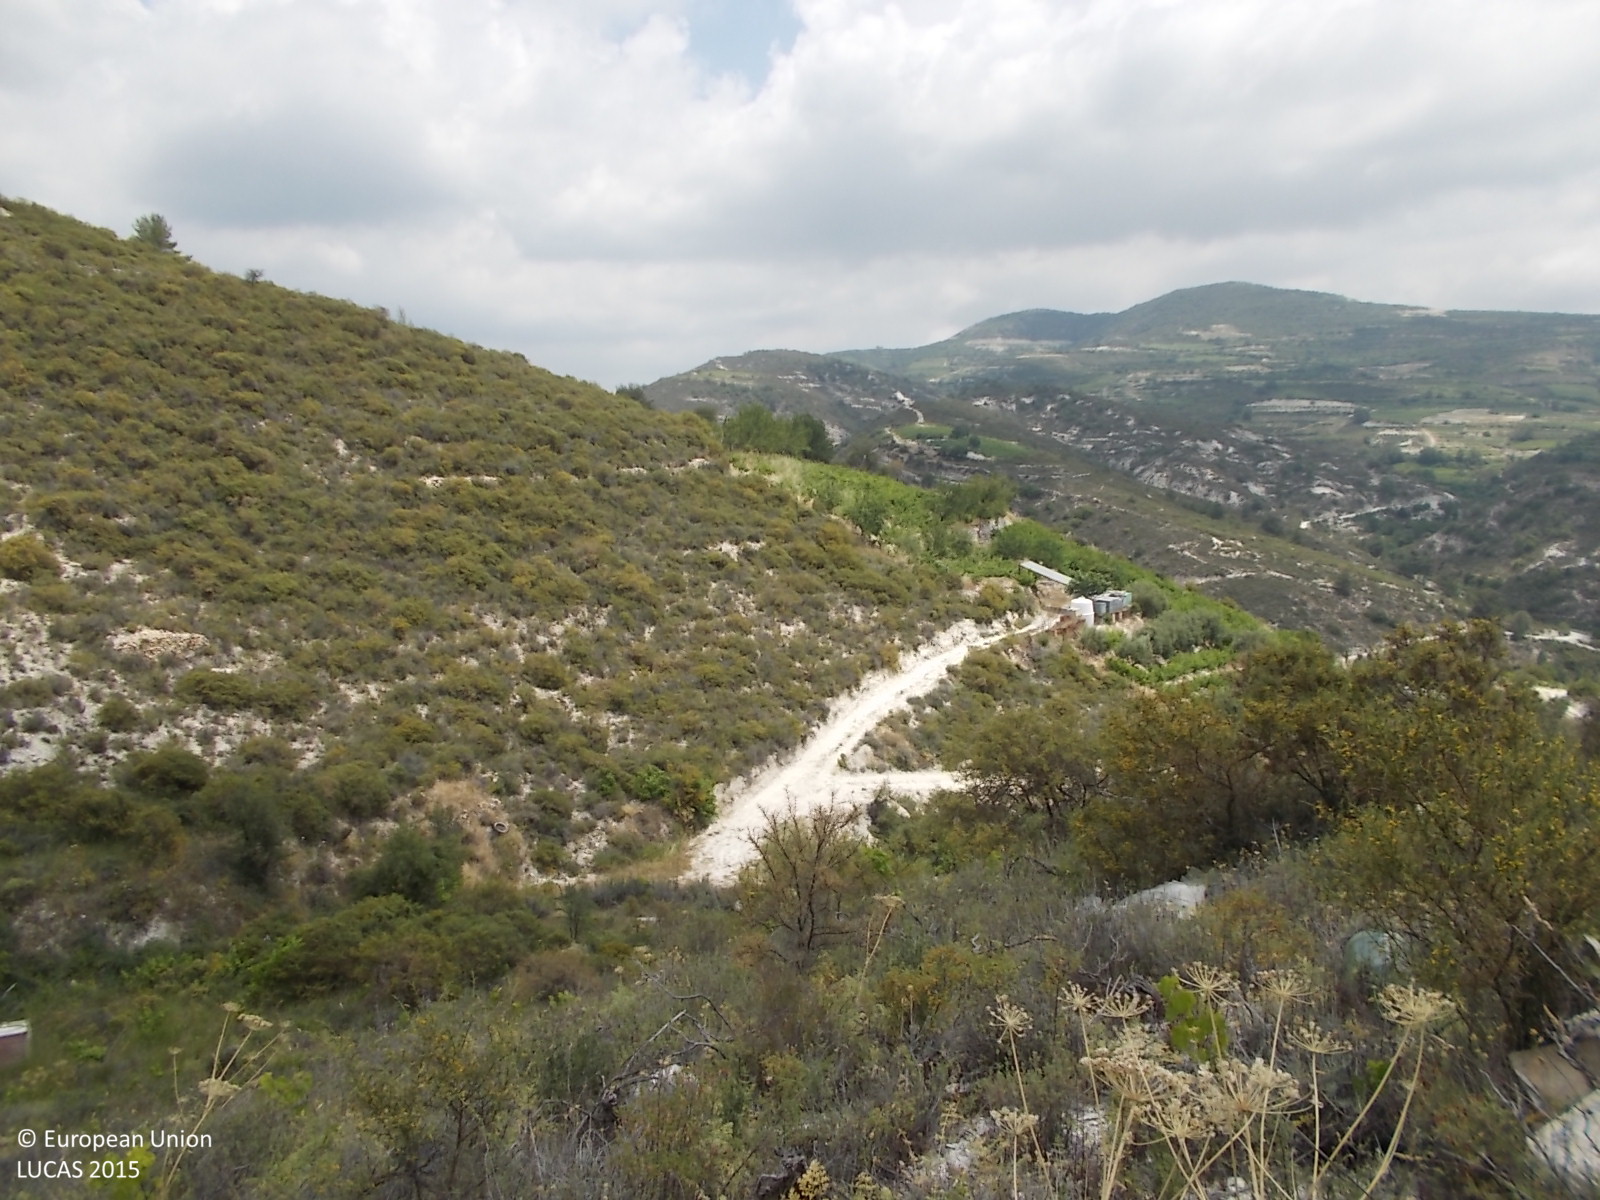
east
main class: Shrubland
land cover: Shrubland without tree cover
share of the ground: 50 - 75 %
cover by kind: shrubs 75 %, consolidated bare surface 15 %, unconsolidated bare surface 10 %
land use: Semi-natural and natural areas not in use
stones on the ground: 25 - 50 %
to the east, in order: Shrubland without tree cover; Tracks; Shrubland without tree cover; Tracks; Shrubland without tree cover; Vineyards; Abandoned hedges; Shrubland without tree cover; Shrubland with sparse tree cover
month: June
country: CY
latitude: 34.8598
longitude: 32.8149
